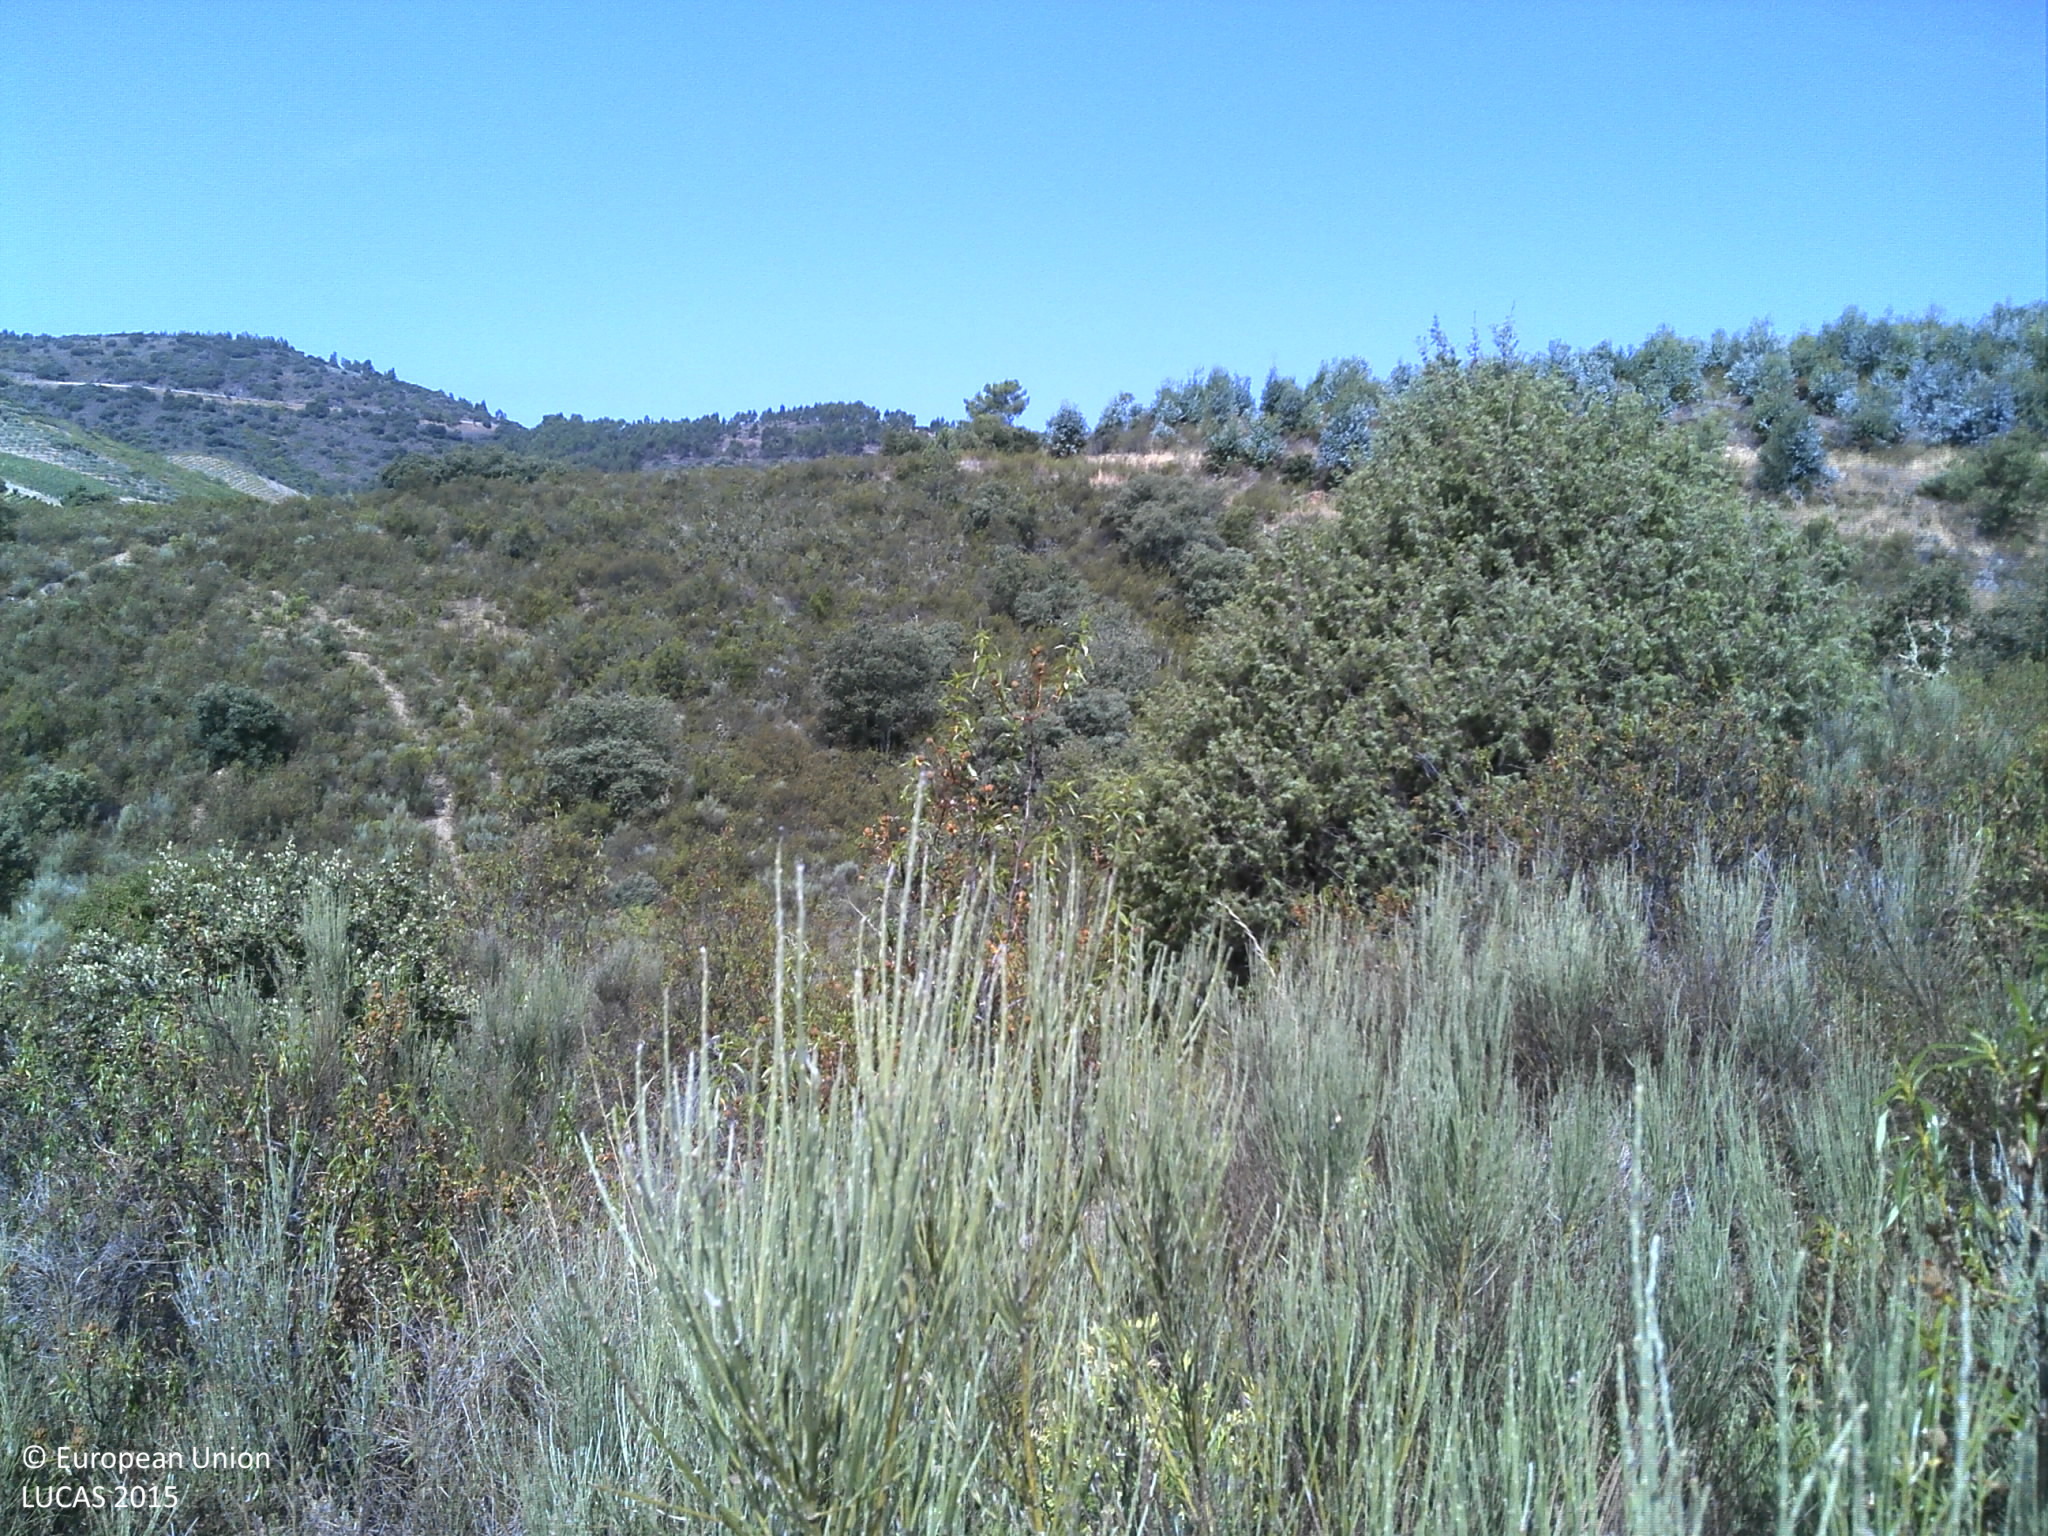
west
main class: Shrubland
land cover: Shrubland with sparse tree cover
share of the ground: > 75 %
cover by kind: shrubs 95 %, broadleaved forest trees 5 %
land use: Semi-natural and natural areas not in use
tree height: < 5 m
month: July
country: PT
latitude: 41.0757
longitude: -7.3143
